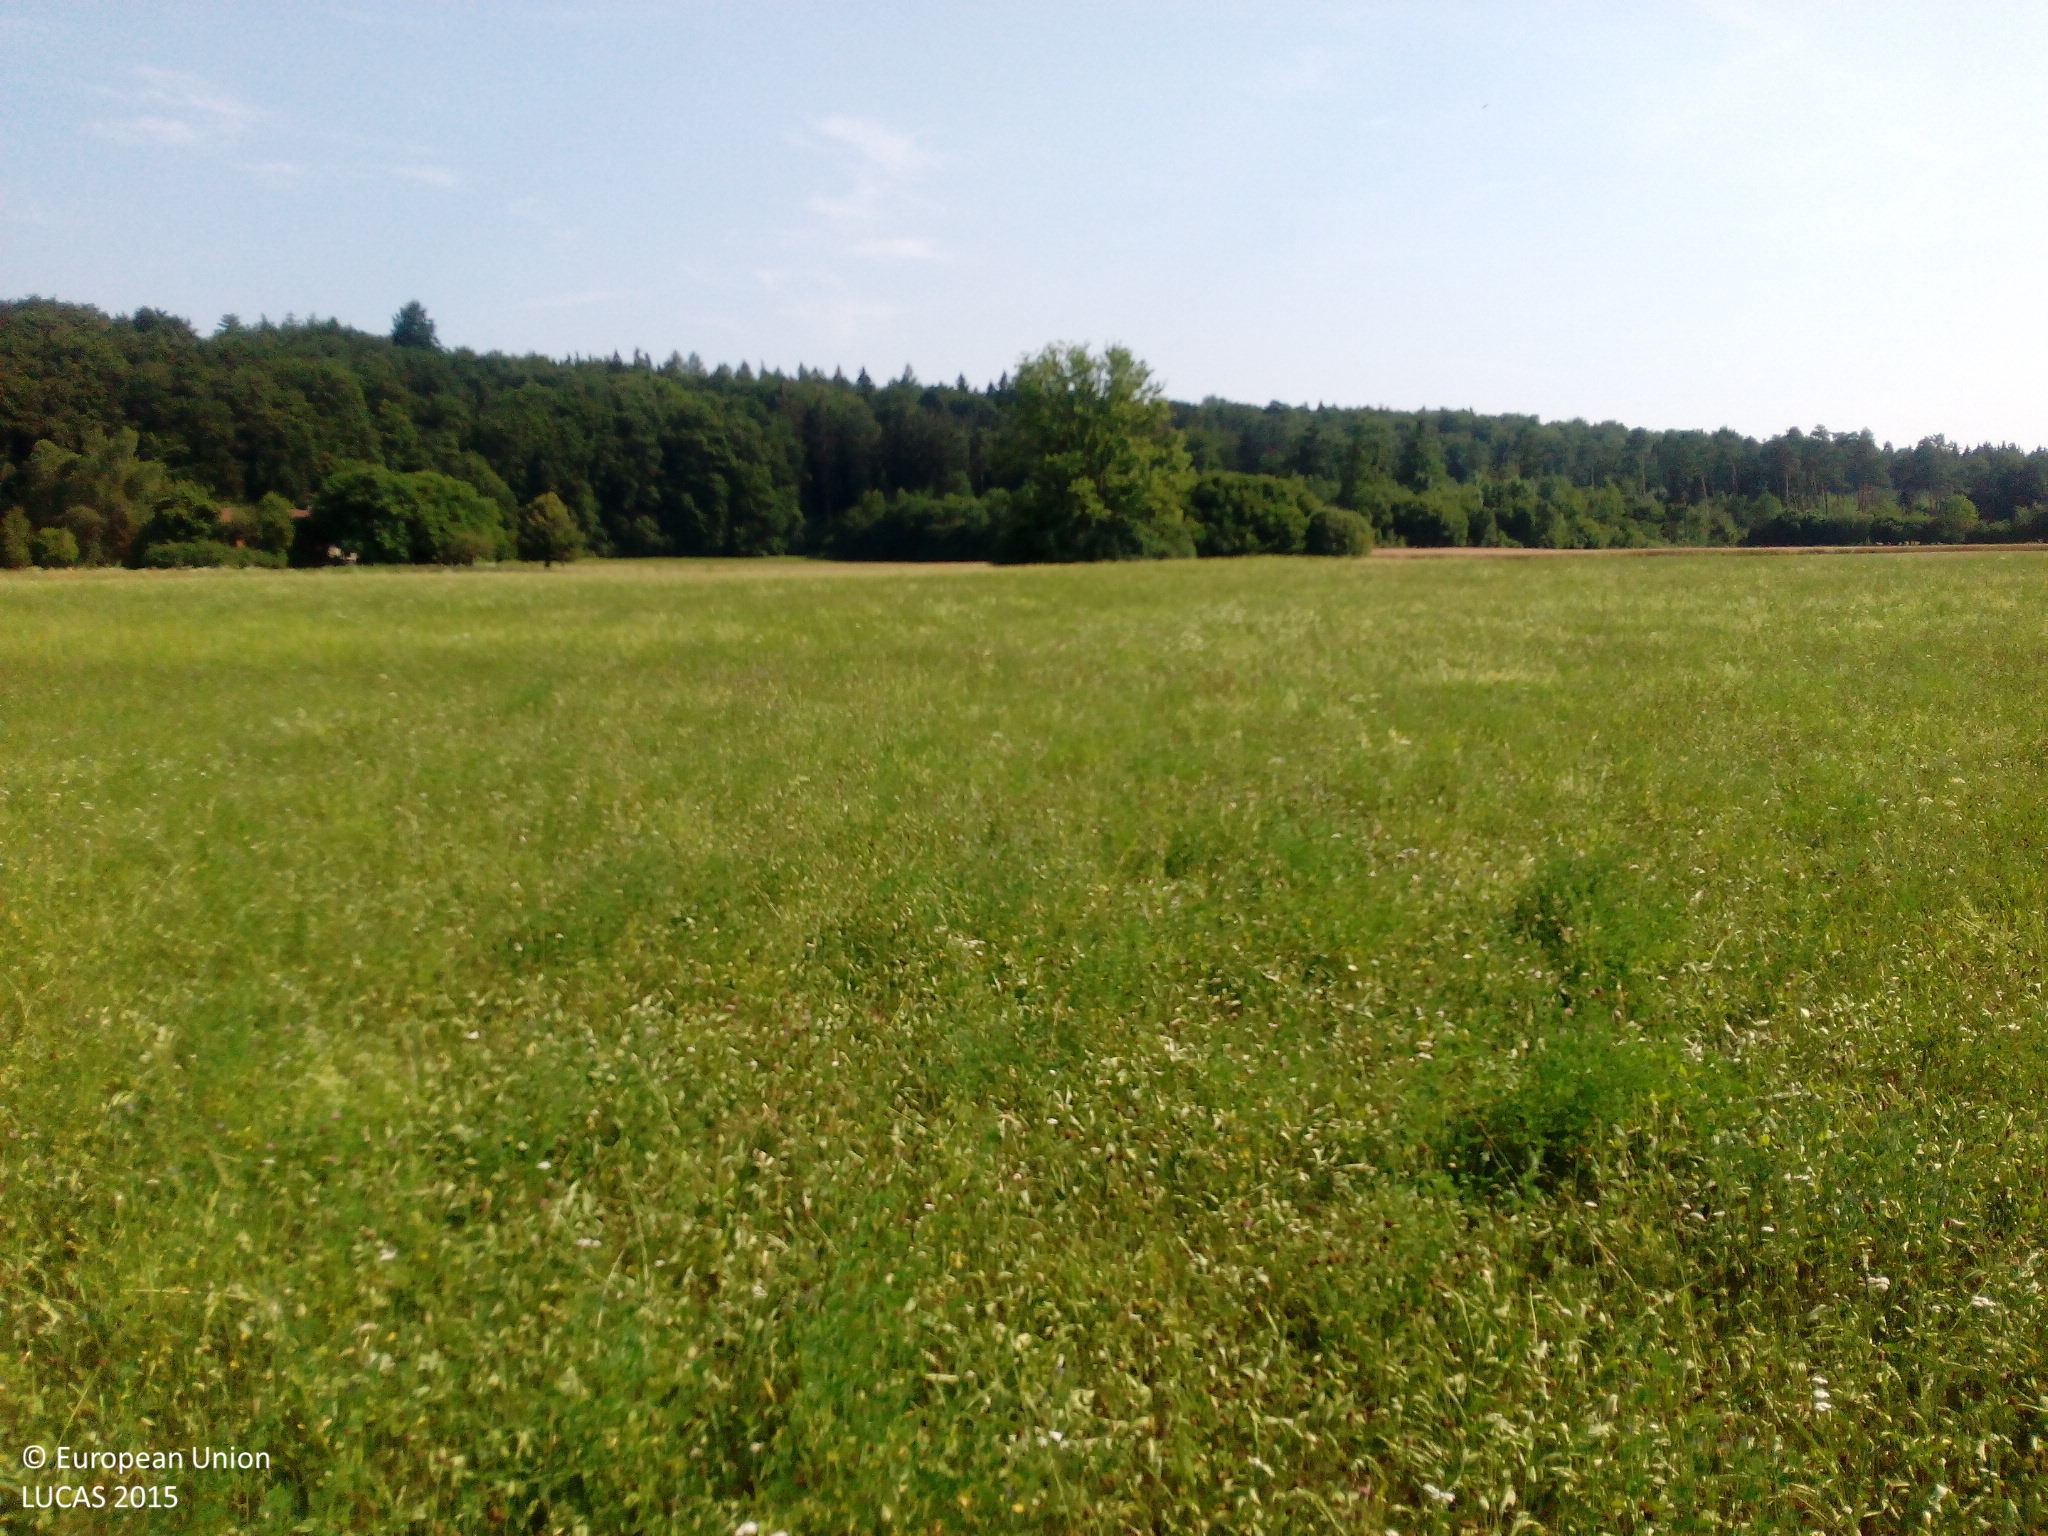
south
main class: Grassland
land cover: Grassland without tree/shrub cover
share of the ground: > 75 %
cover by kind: herbaceous plants 100 %
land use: Agriculture (excluding fallow land and kitchen gardens)
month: July
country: DE
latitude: 48.2237
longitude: 12.8123
